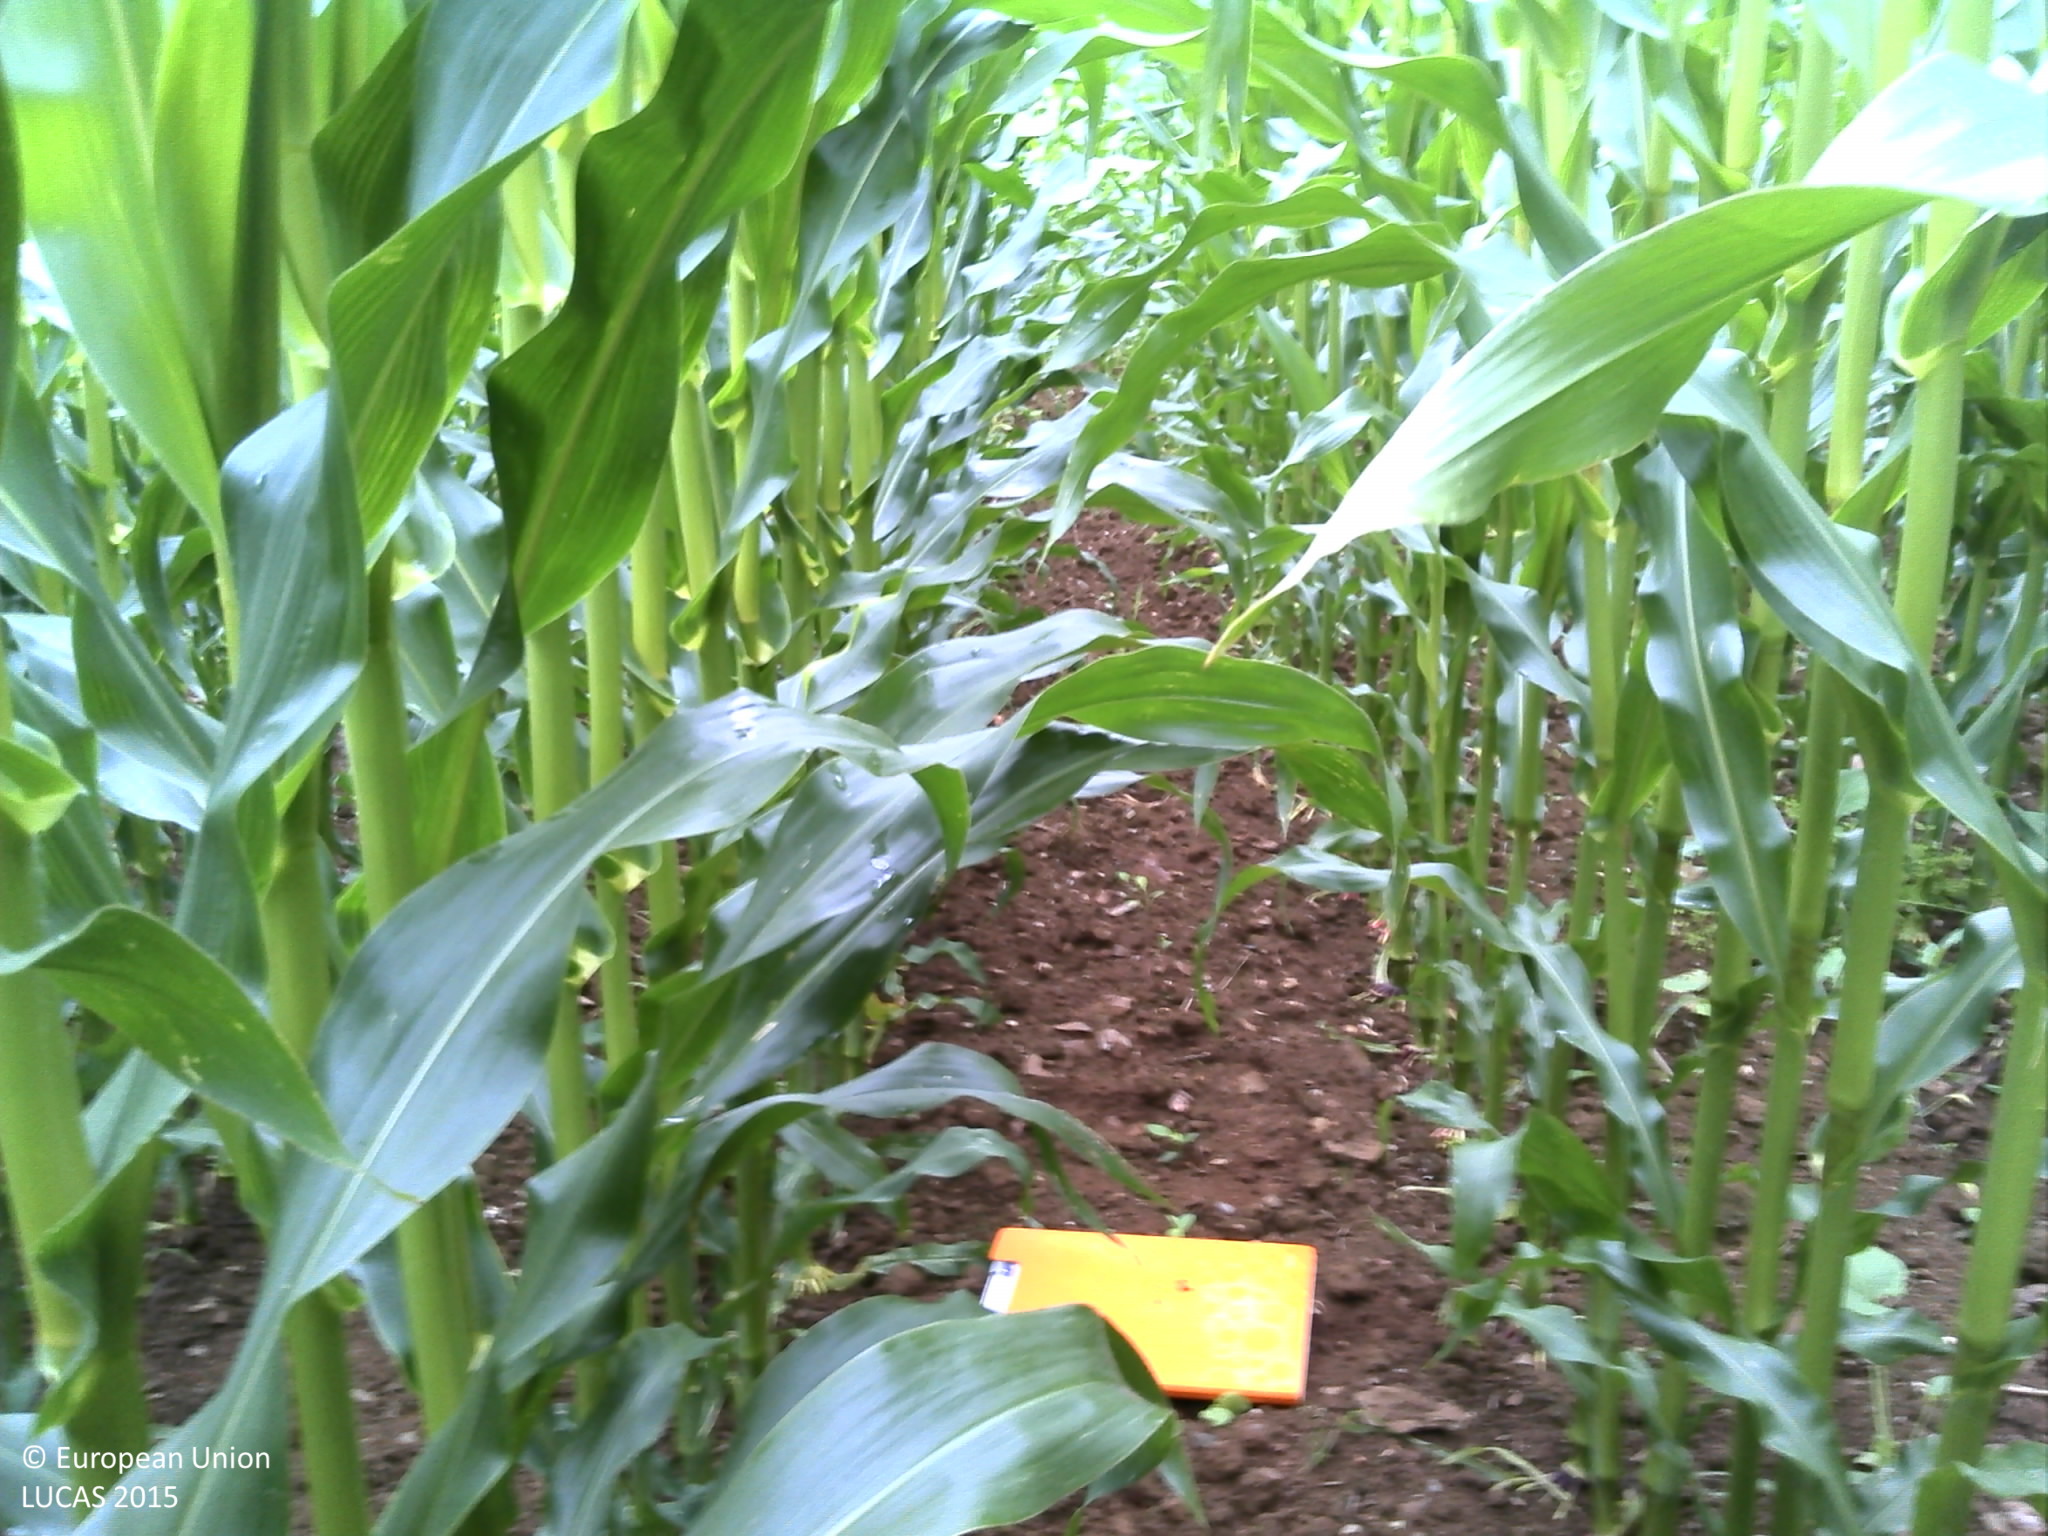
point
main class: Cropland
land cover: Maize
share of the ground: > 75 %
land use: Agriculture (excluding fallow land and kitchen gardens)
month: July
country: FR
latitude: 48.4500
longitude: -4.1942
